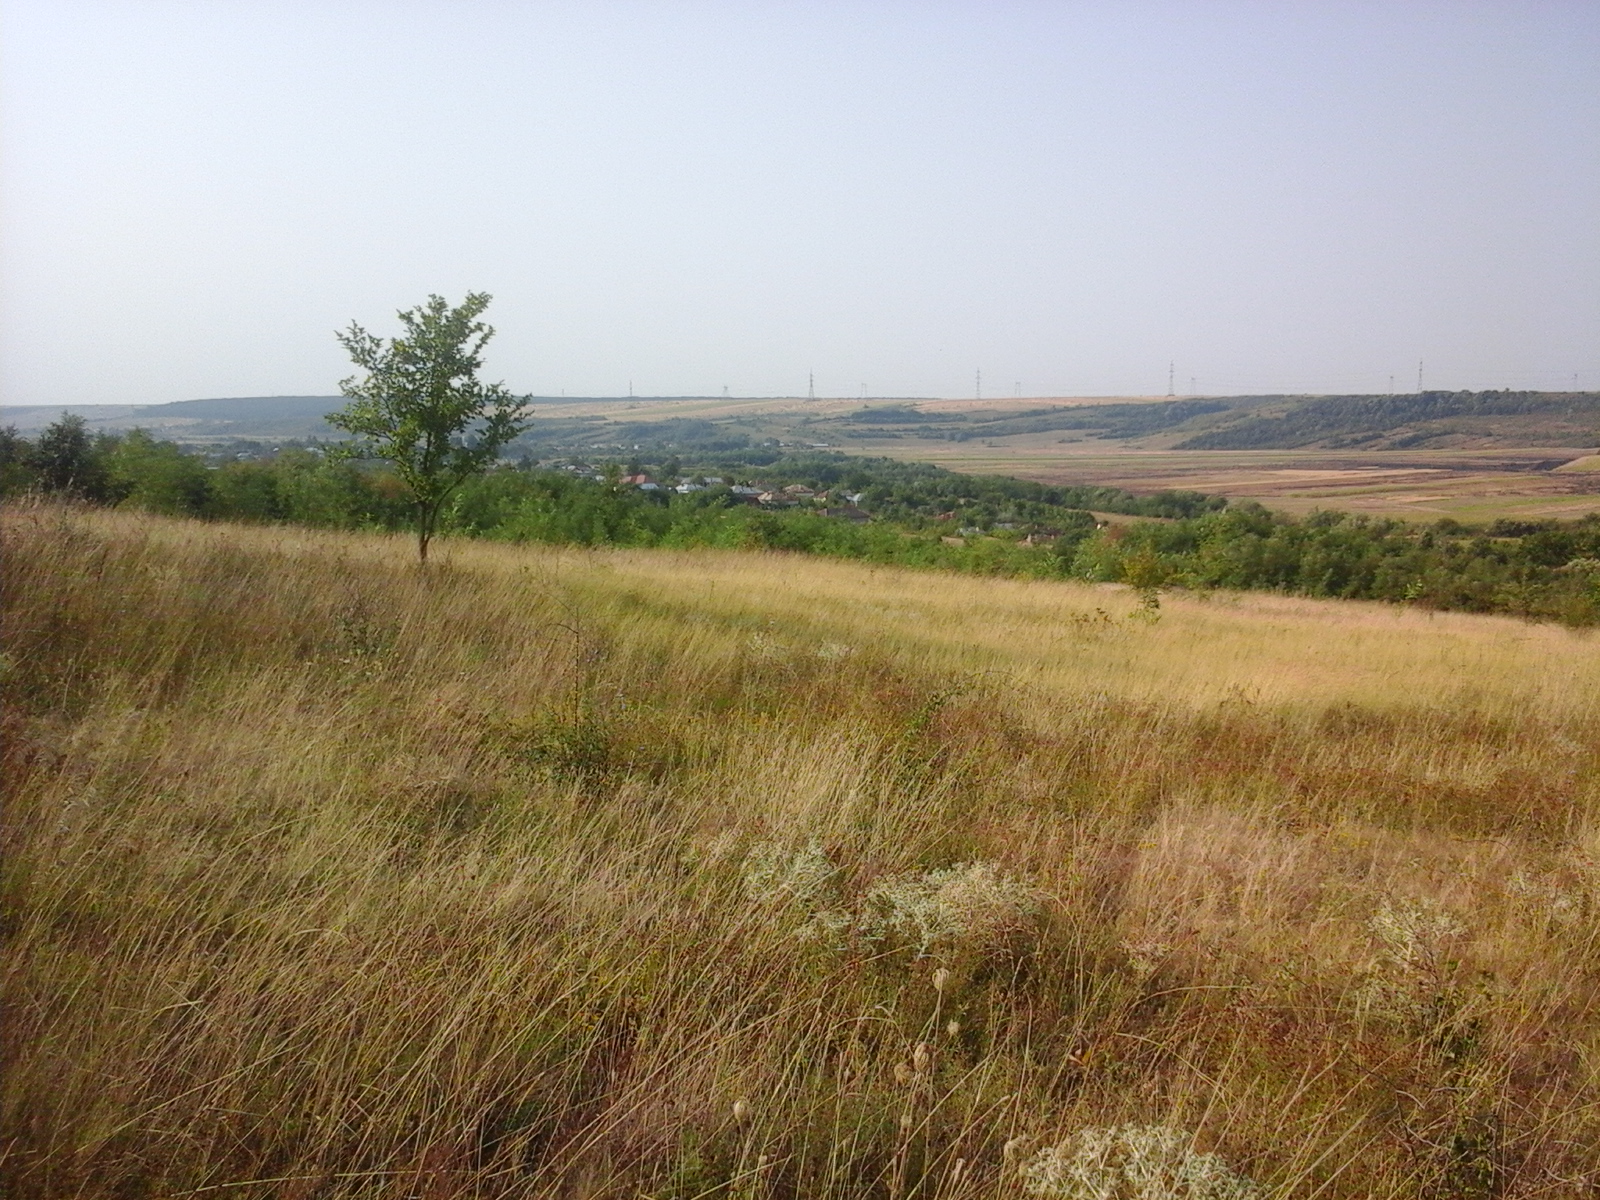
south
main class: Grassland
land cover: Grassland with sparse tree/shrub cover
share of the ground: > 75 %
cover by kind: herbaceous plants 90 %, broadleaved forest trees 5 %, shrubs 5 %
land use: Fallow land
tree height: < 5 m
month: August
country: RO
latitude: 44.5120
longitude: 23.8592
